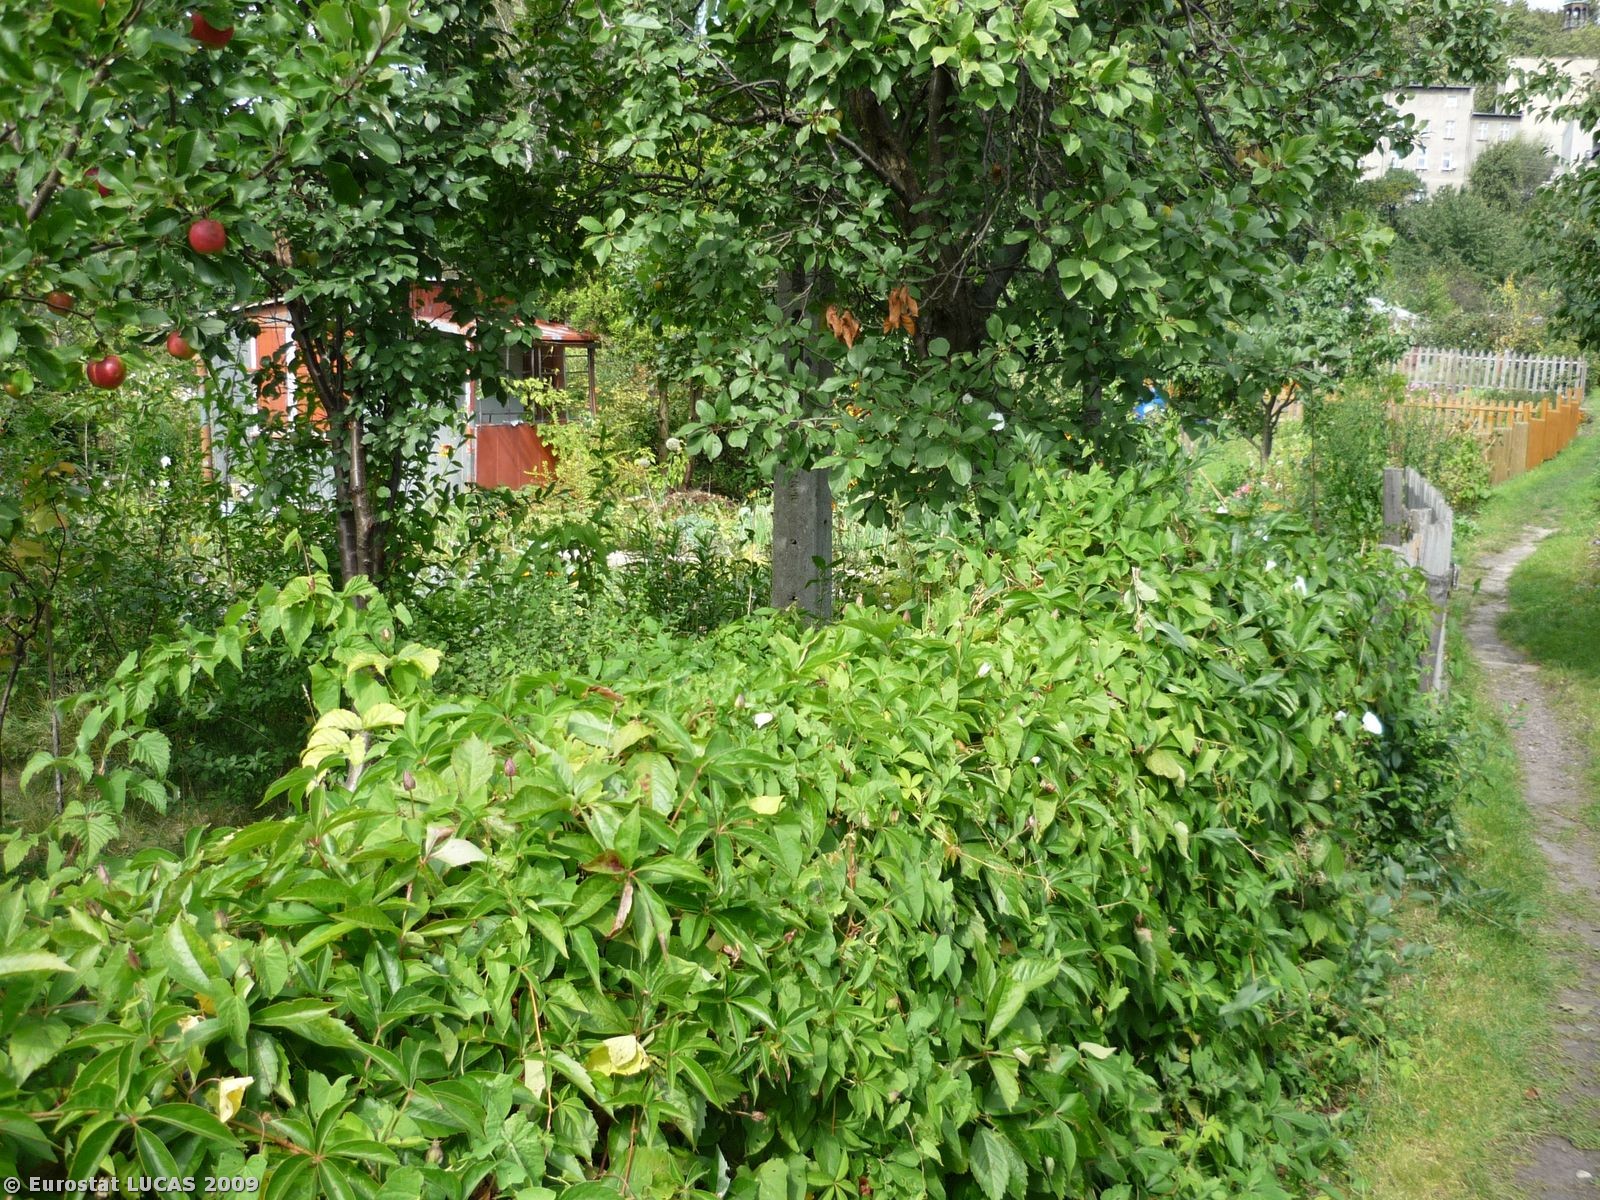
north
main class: Cropland
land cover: Apple fruit
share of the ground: 50 - 75 %
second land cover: Grassland with sparse tree/shrub cover
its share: > 75 %
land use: Kitchen garden
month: September
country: PL
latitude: 50.7549
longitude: 16.2010
